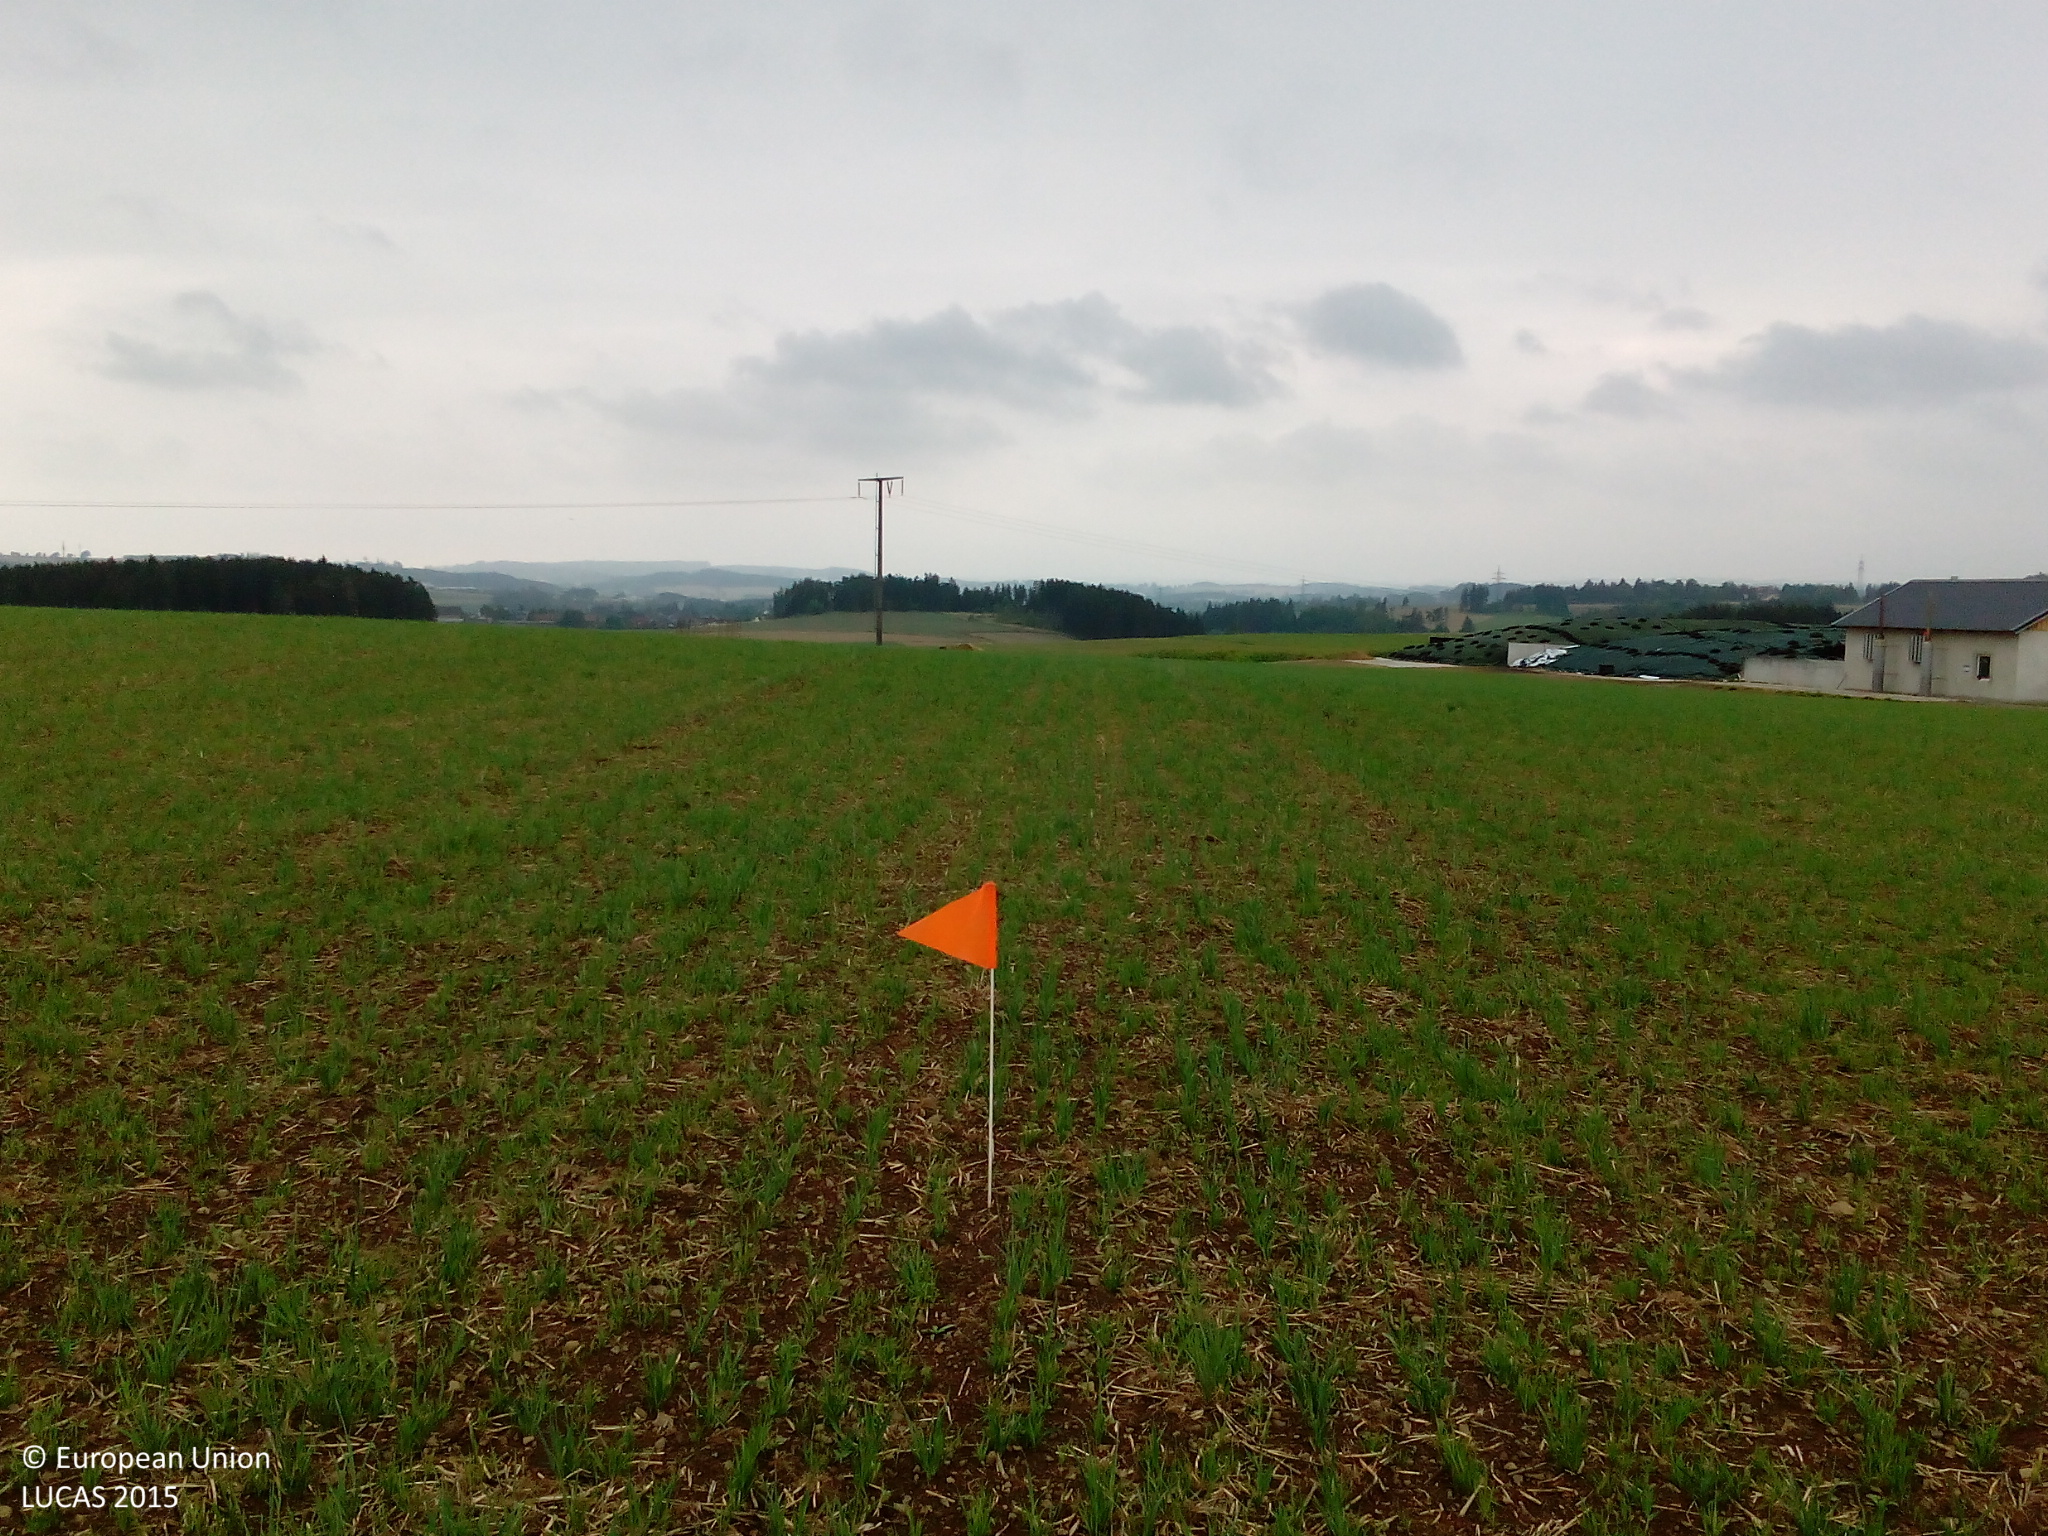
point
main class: Cropland
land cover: Common wheat
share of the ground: 25 - 50 %
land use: Agriculture (excluding fallow land and kitchen gardens)
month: August
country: DE
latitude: 50.3110
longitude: 11.9796
